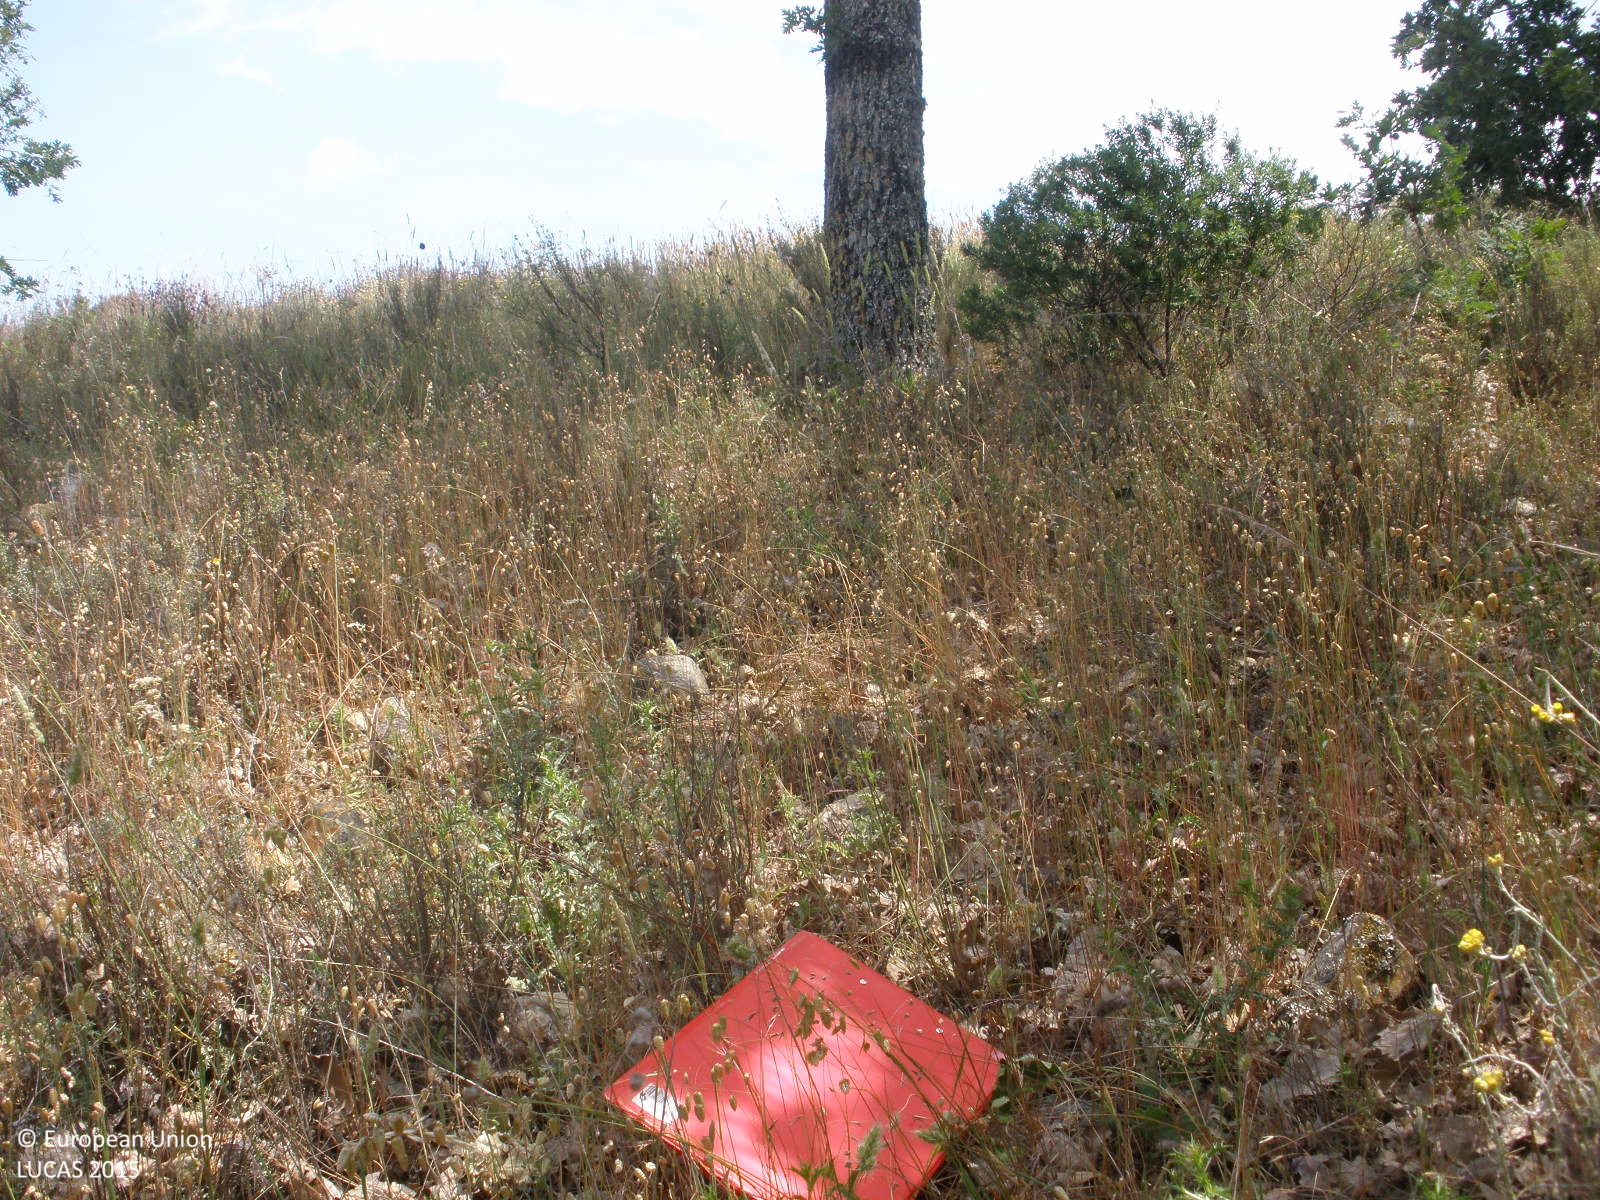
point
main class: Woodland
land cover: Broadleaved woodland
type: thermophilous deciduous forest
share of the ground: > 75 %
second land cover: Grassland without tree/shrub cover
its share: > 75 %
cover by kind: broadleaved forest trees 60 %, herbaceous plants 30 %, shrubs 10 %
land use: Forestry
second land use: Agriculture (excluding fallow land and kitchen gardens)
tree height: > 5 m
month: June
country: ES
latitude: 40.5863
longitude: -6.3066
